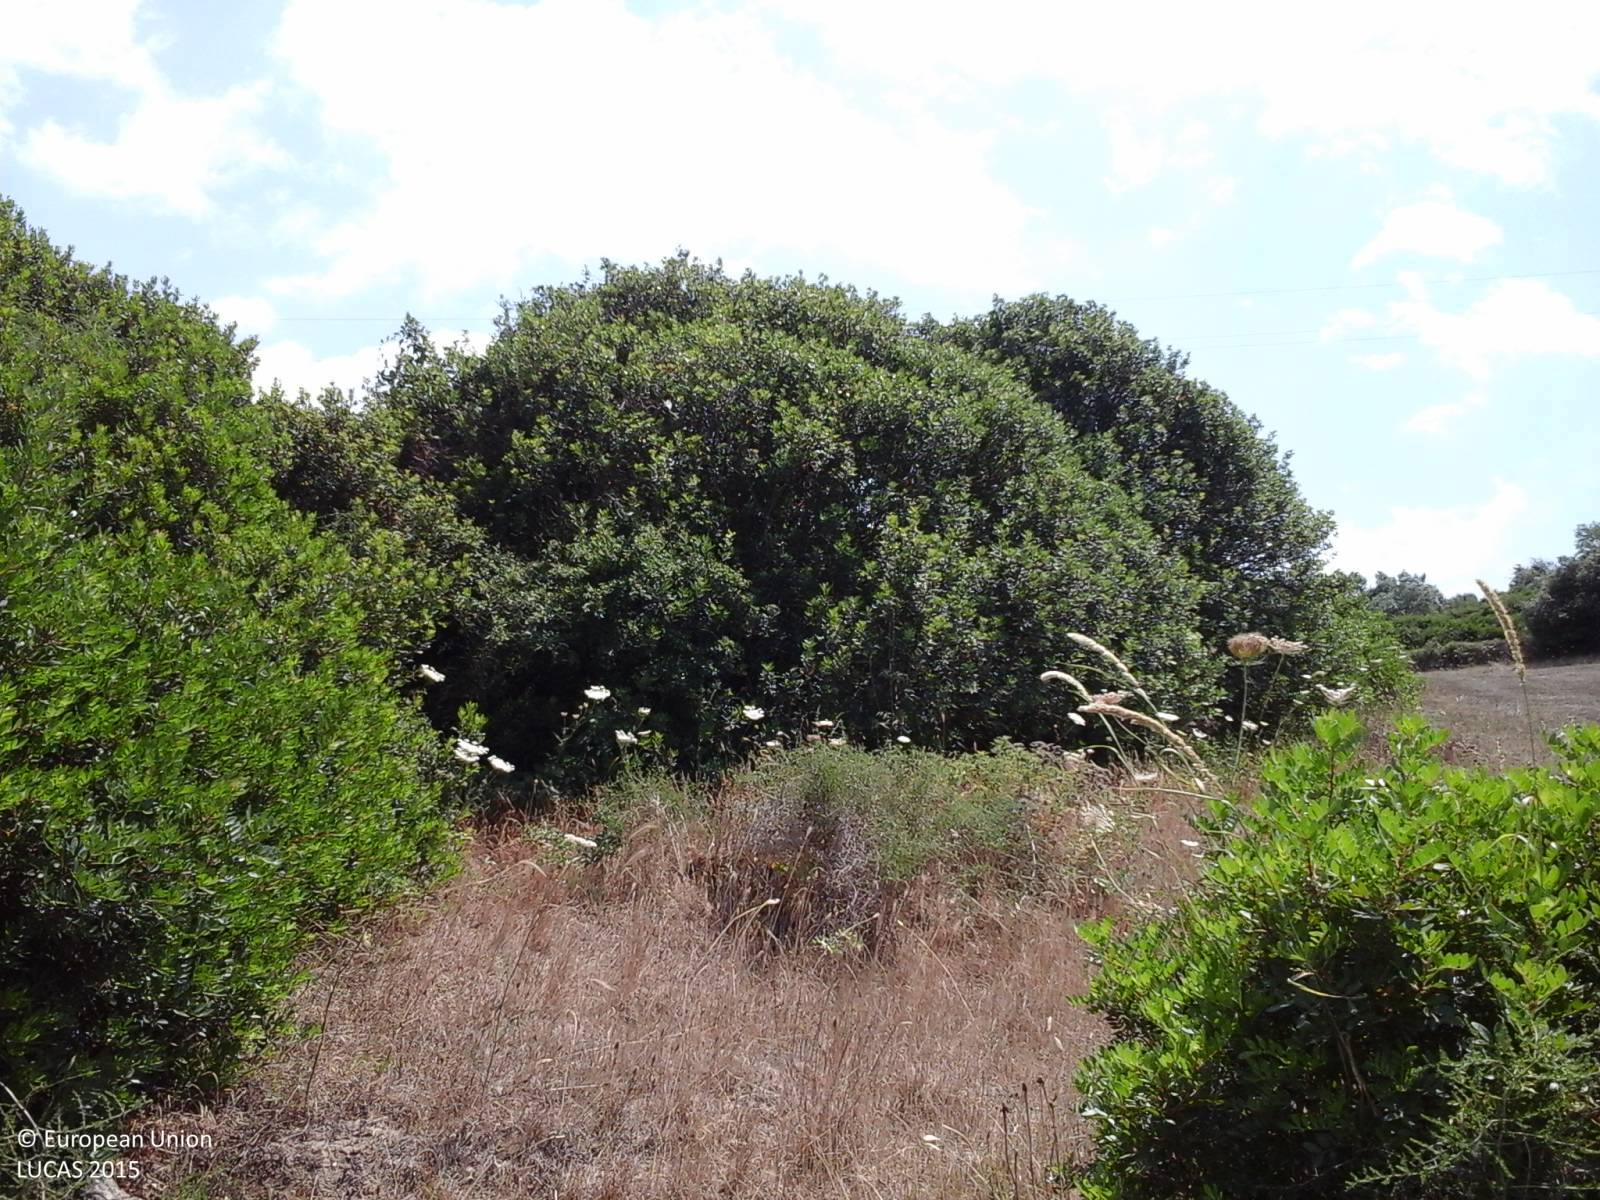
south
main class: Grassland
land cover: Grassland without tree/shrub cover
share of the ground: > 75 %
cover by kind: herbaceous plants 100 %
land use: Agriculture (excluding fallow land and kitchen gardens)
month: June
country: IT
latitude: 39.8627
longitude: 8.8956
